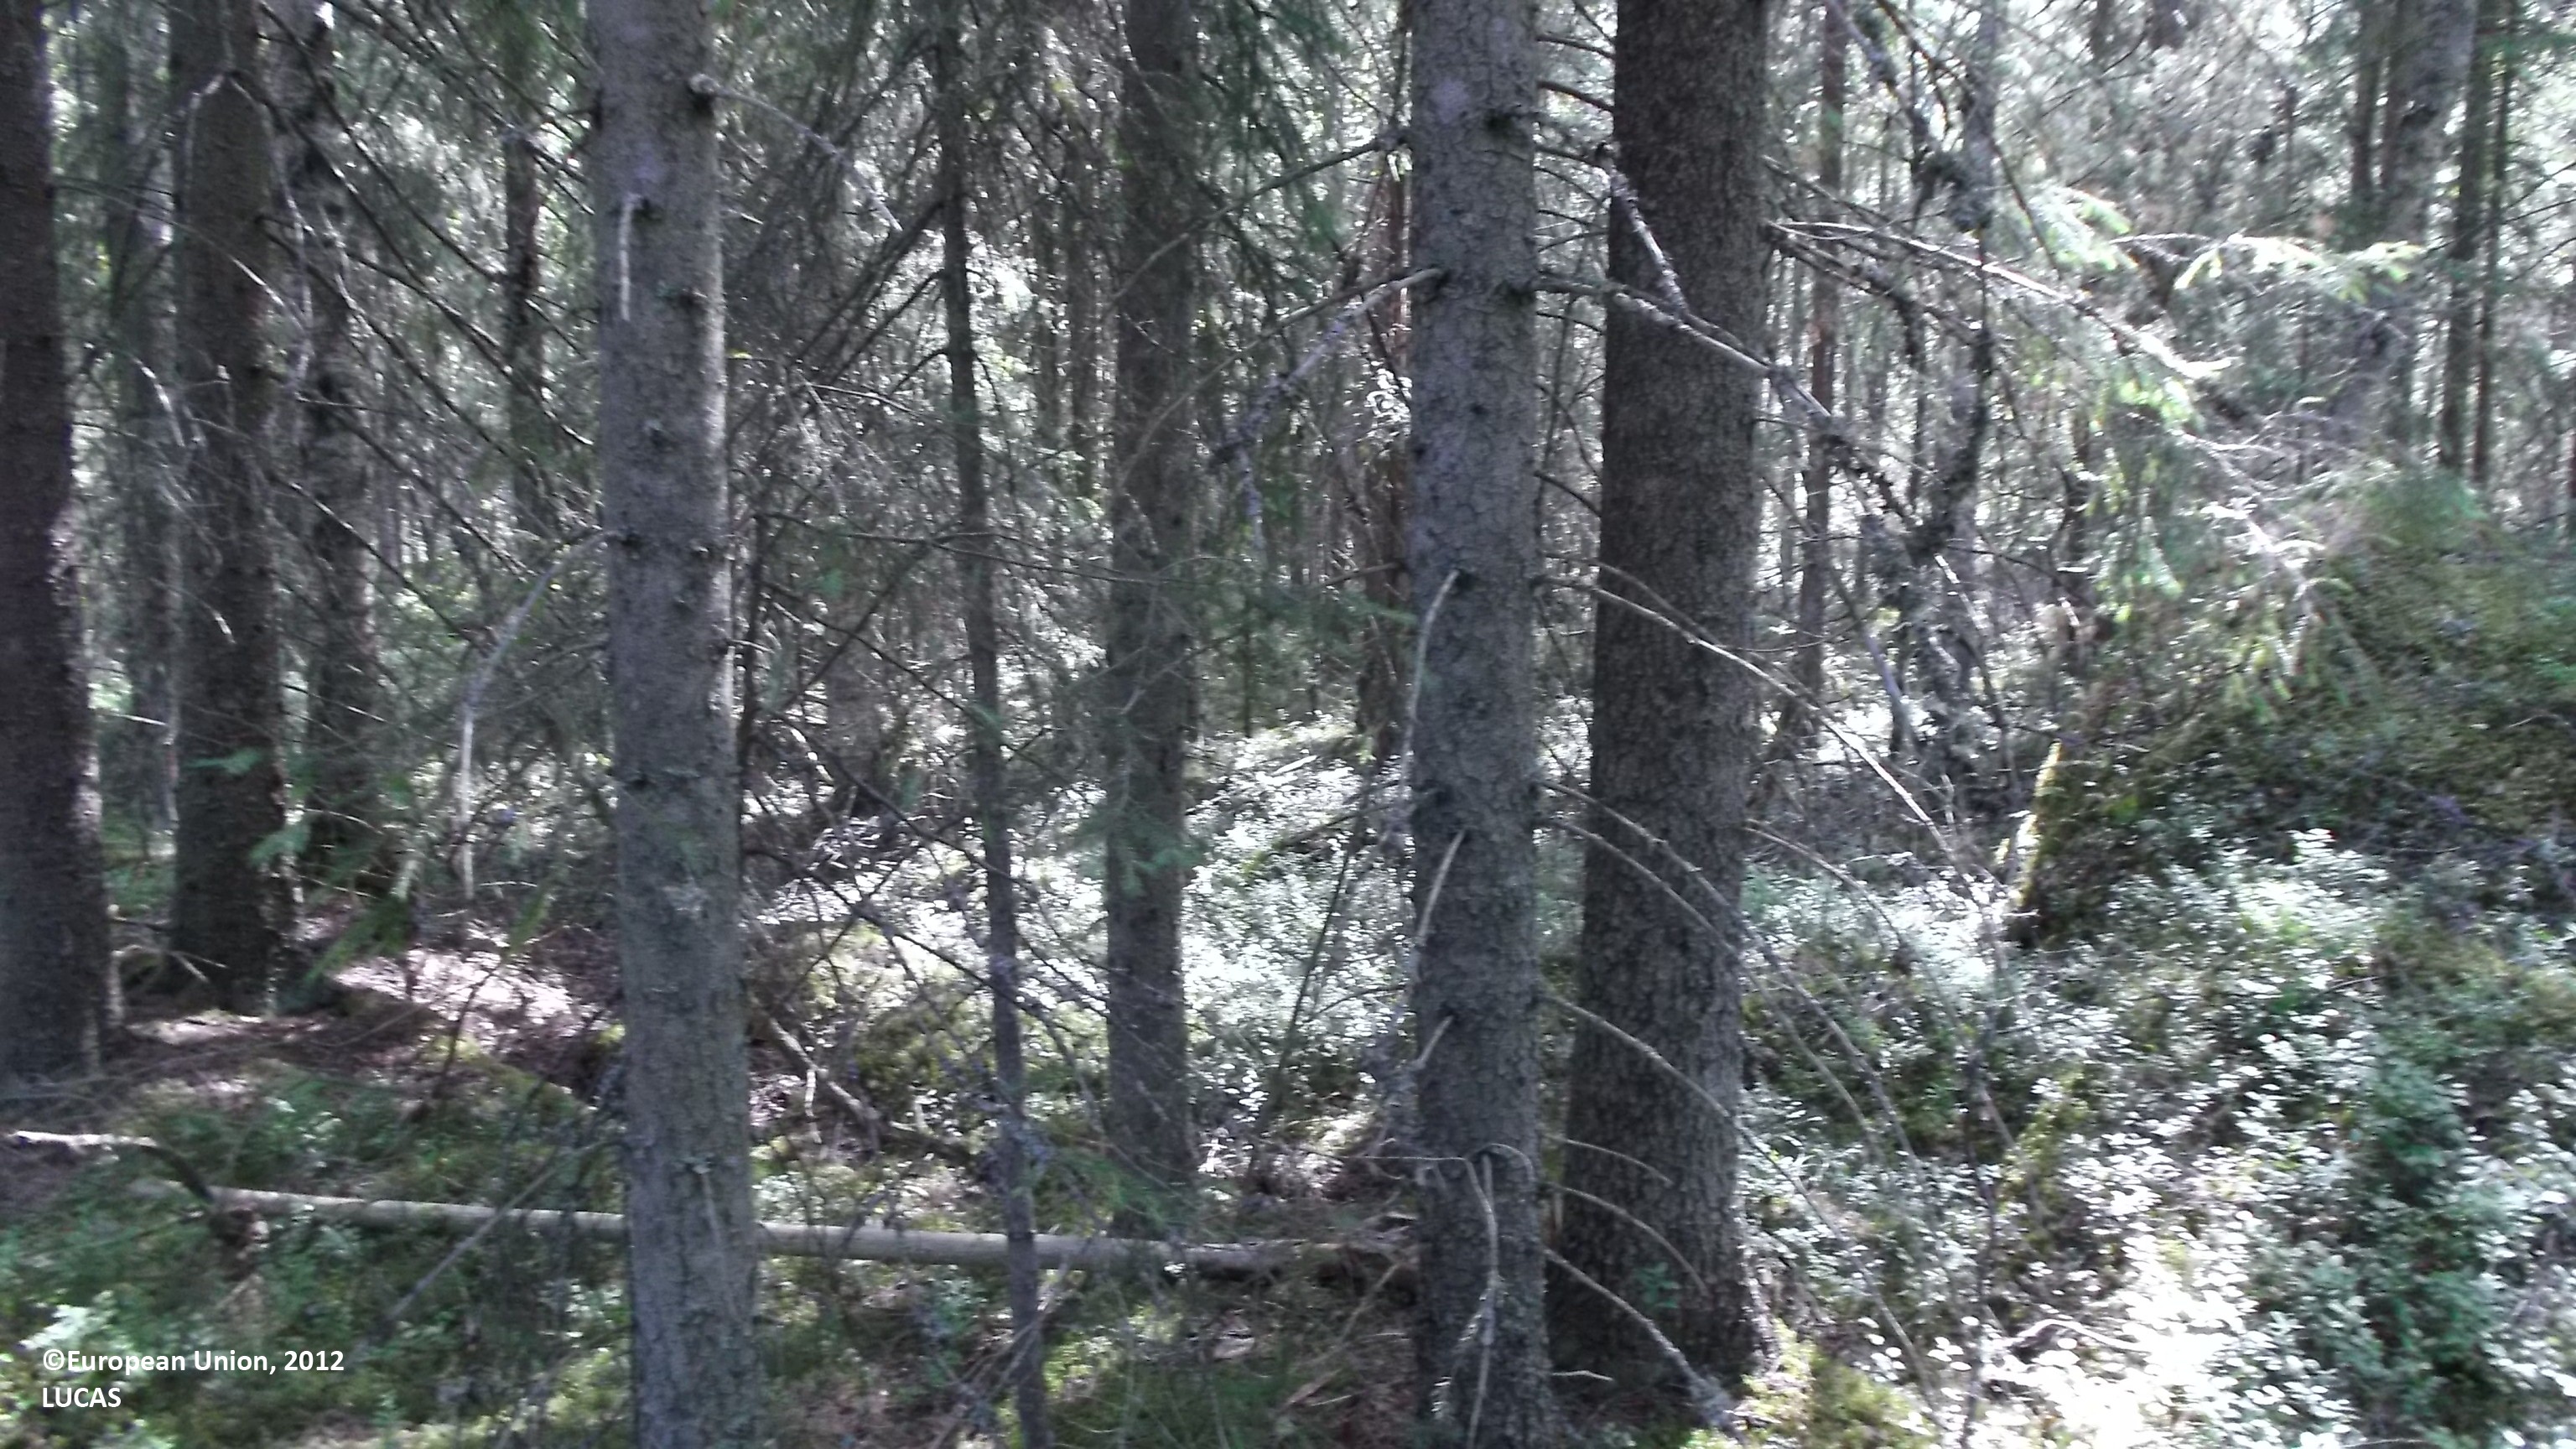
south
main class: Woodland
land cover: Spruce dominated coniferous woodland
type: boreal forest
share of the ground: > 75 %
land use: Forestry
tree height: > 5 m
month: July
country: FI
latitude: 63.6642
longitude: 23.9891
